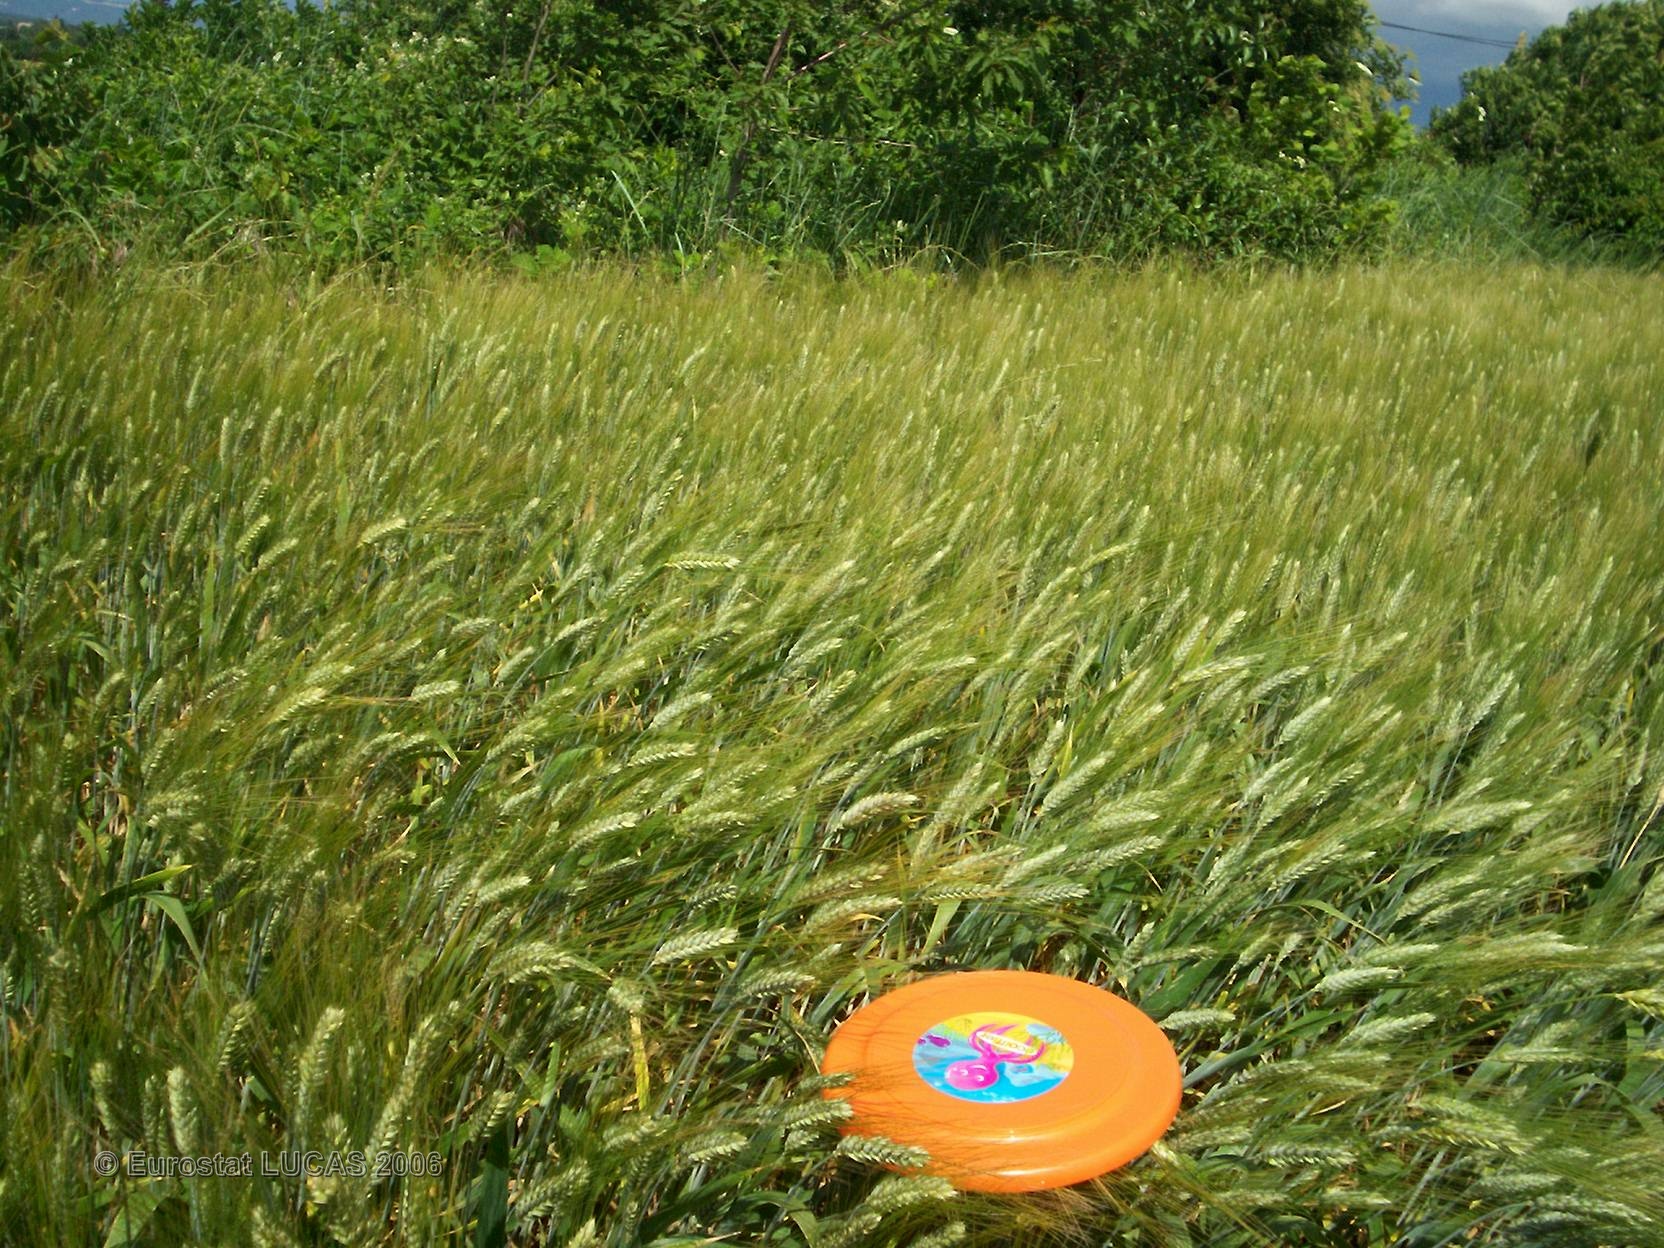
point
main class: Cropland
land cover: Durum wheat
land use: Agriculture (excluding fallow land and kitchen gardens)
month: May
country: FR
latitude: 44.5651
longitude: 4.8318
